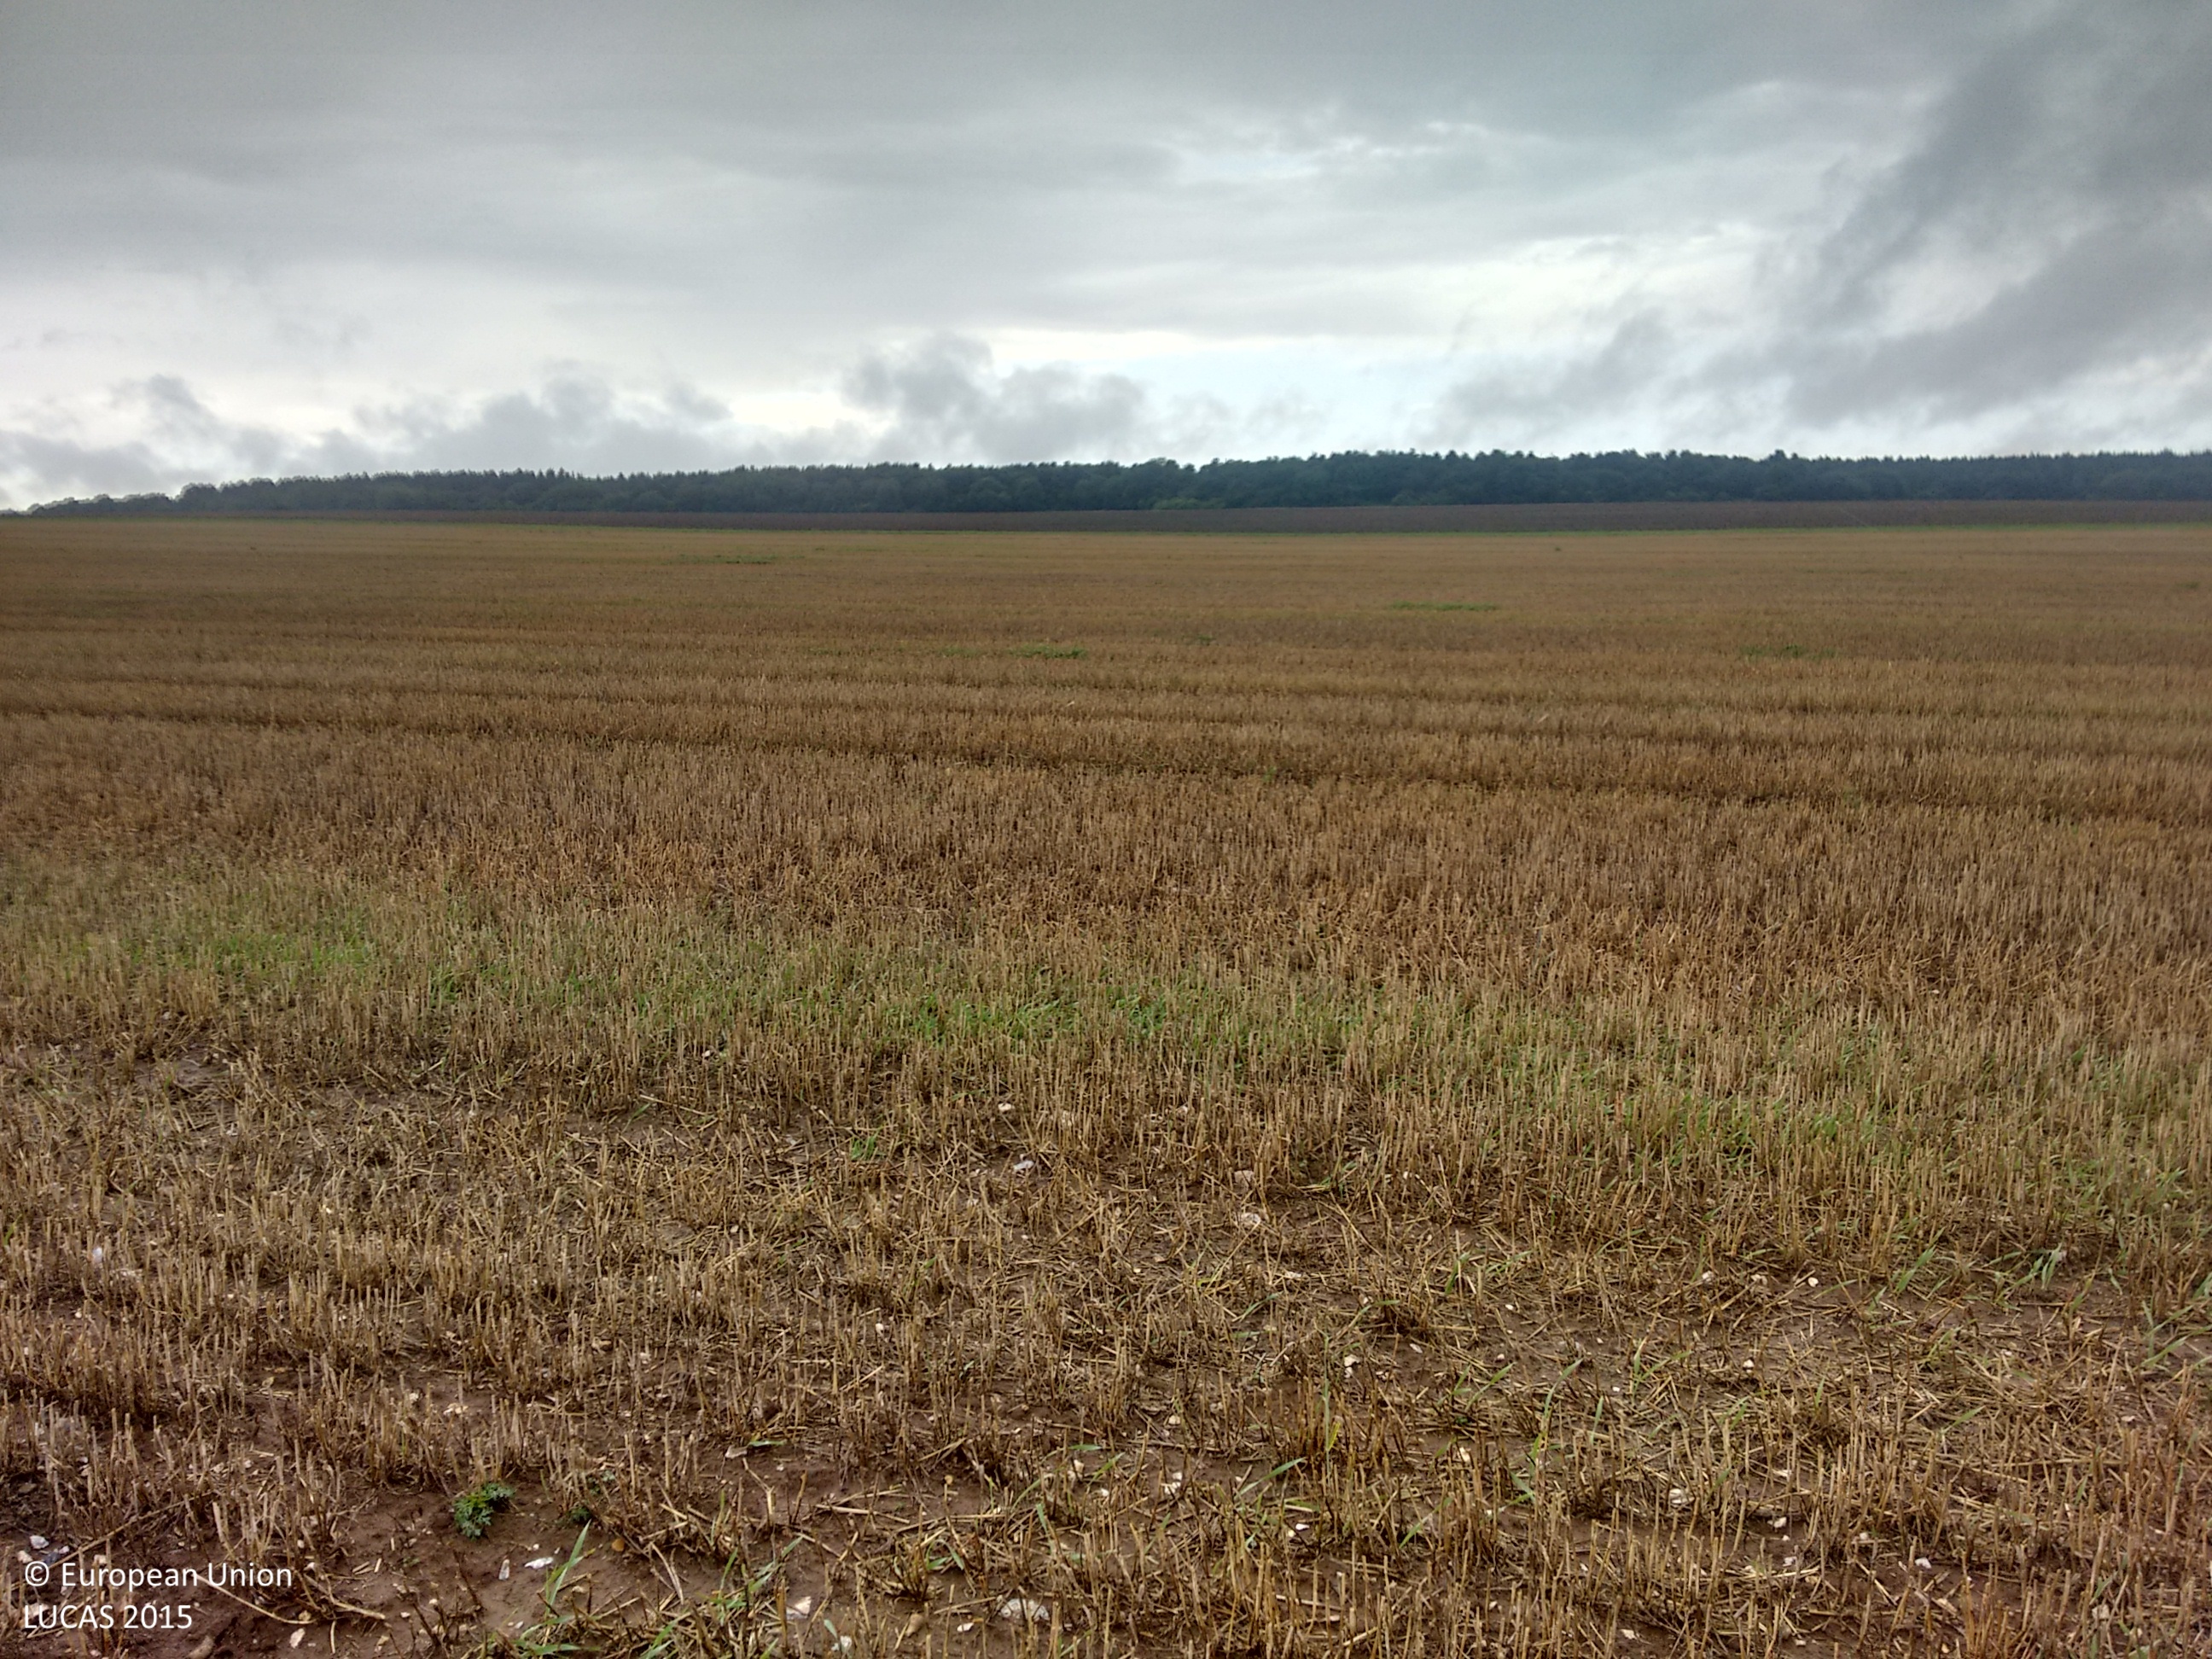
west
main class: Cropland
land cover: Barley
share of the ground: 50 - 75 %
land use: Agriculture (excluding fallow land and kitchen gardens)
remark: Harvested field
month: August
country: GB
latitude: 52.1077
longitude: 0.3193
